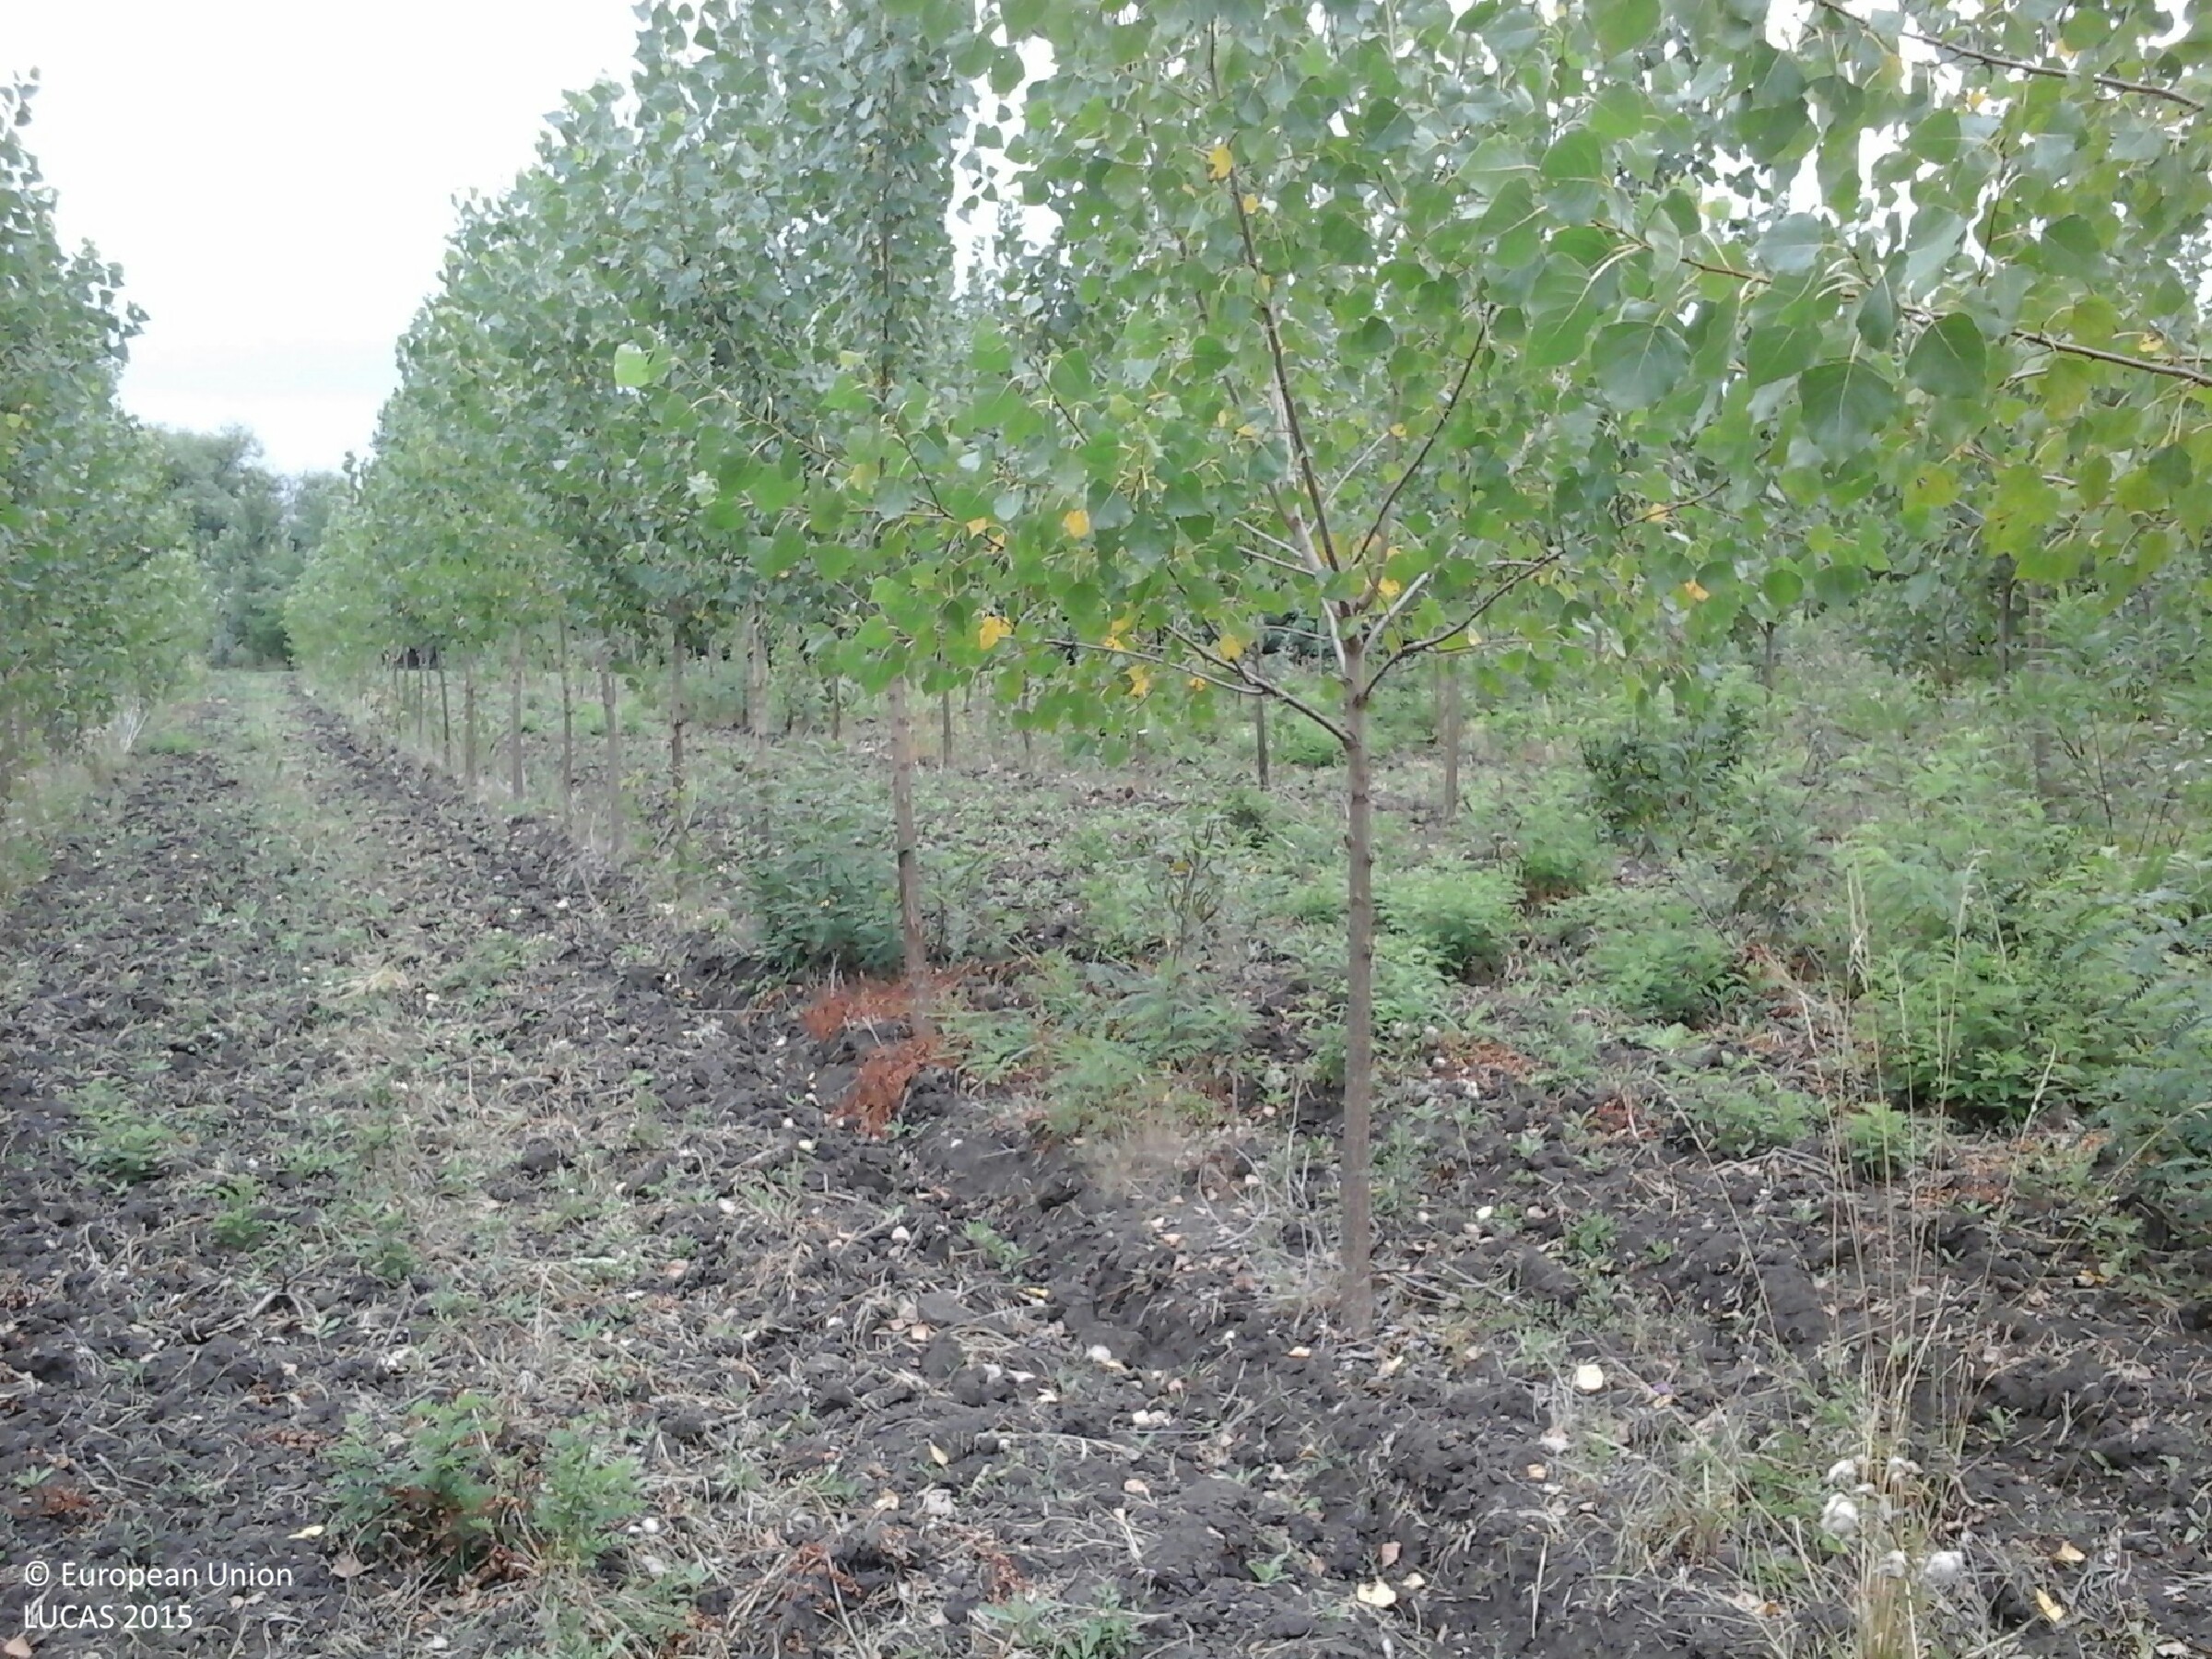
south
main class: Woodland
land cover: Broadleaved woodland
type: non-riverine alder, birch or aspen forest
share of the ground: 50 - 75 %
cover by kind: broadleaved forest trees 50 %, unconsolidated bare surface 35 %, herbaceous plants 15 %
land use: Forestry
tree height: < 5 m
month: July
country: HU
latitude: 47.4617
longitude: 20.5510
